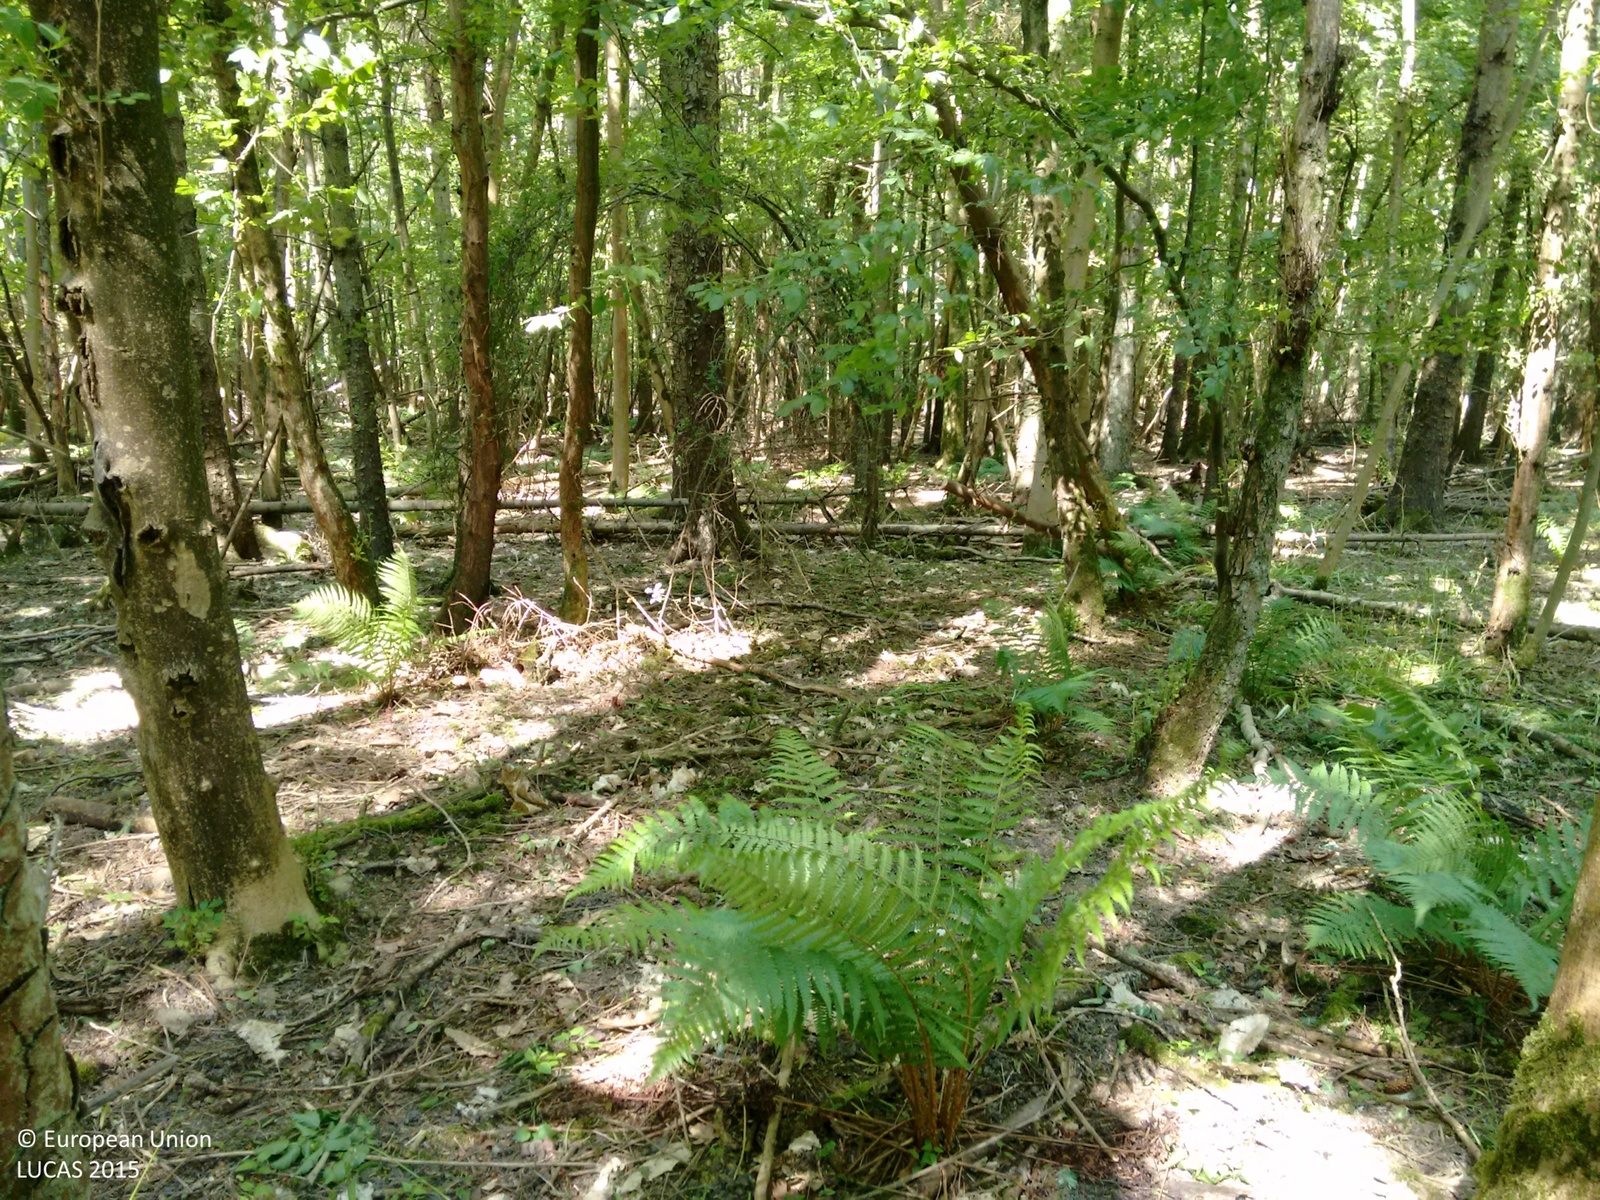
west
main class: Woodland
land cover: Other mixed woodland
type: exotic forest
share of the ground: > 75 %
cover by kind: coniferous forest trees 50 %, broadleaved forest trees 50 %
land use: Forestry
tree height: > 5 m
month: June
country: GB
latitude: 50.9818
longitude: 0.4998
